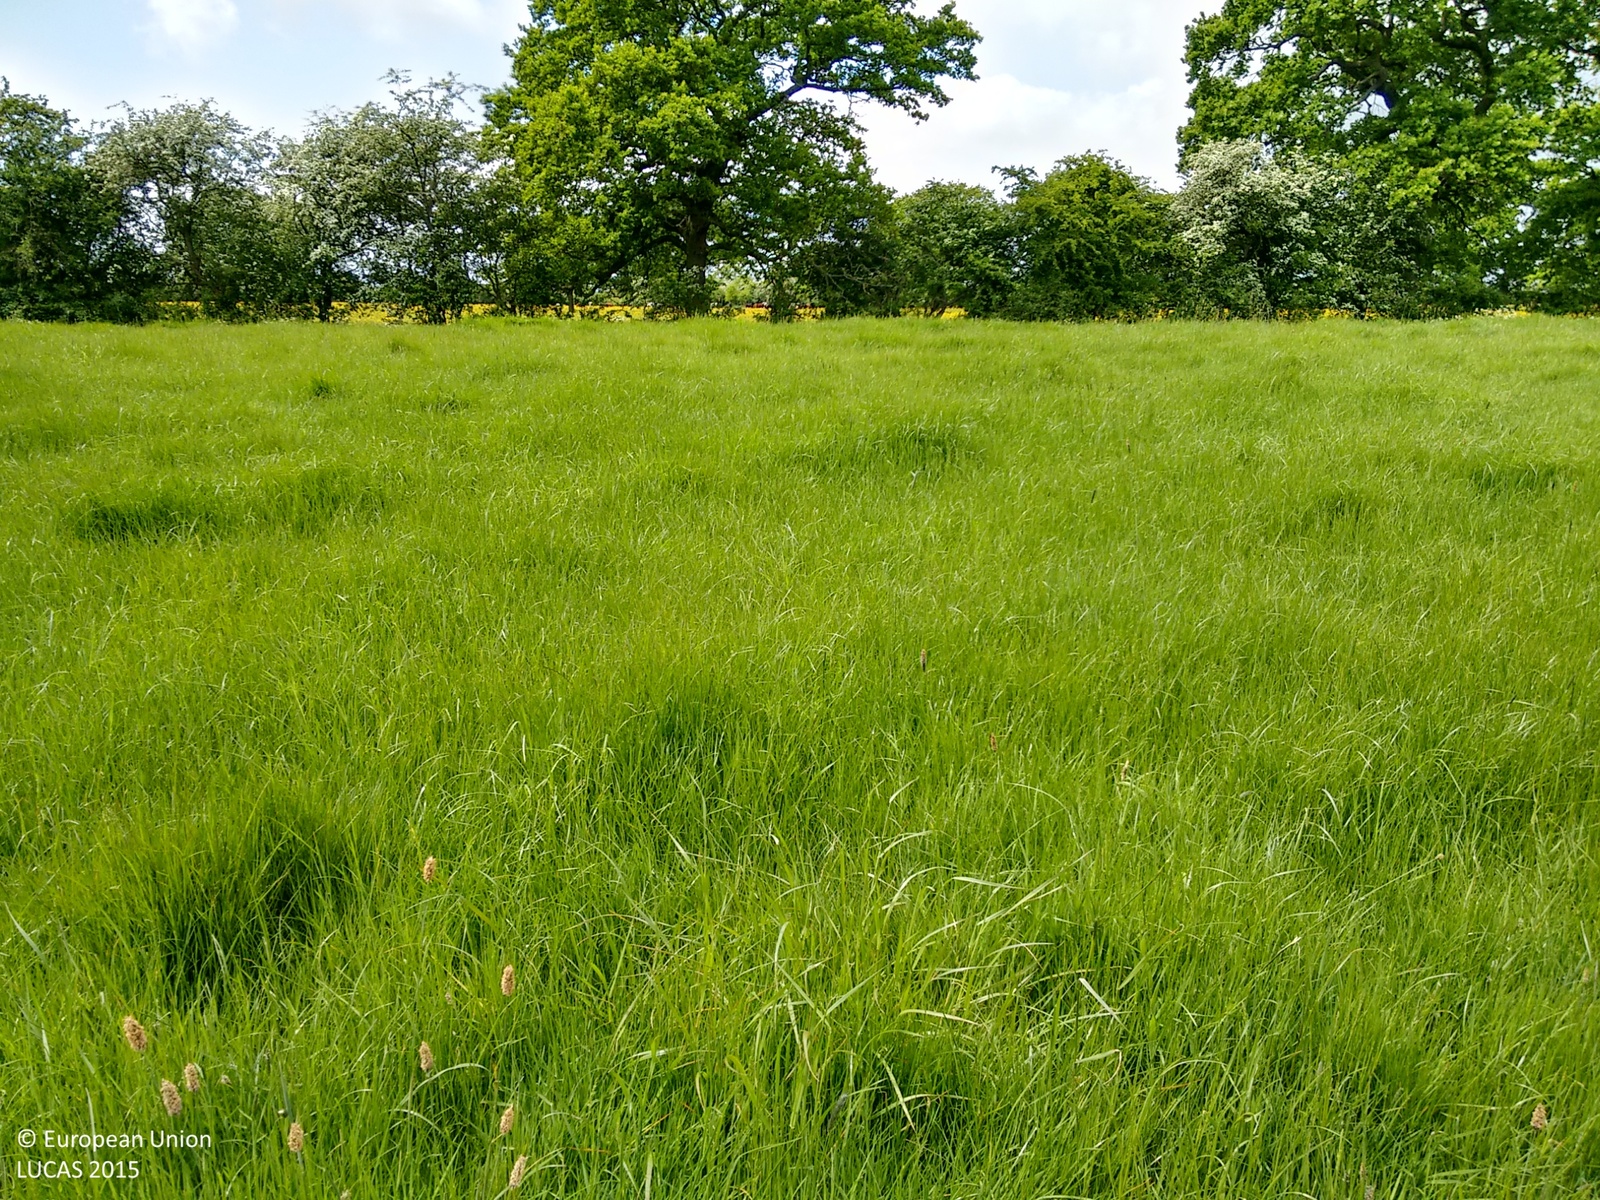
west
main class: Grassland
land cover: Grassland without tree/shrub cover
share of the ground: > 75 %
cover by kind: herbaceous plants 100 %
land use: Agriculture (excluding fallow land and kitchen gardens)
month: May
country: GB
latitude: 53.9683
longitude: -1.2195
